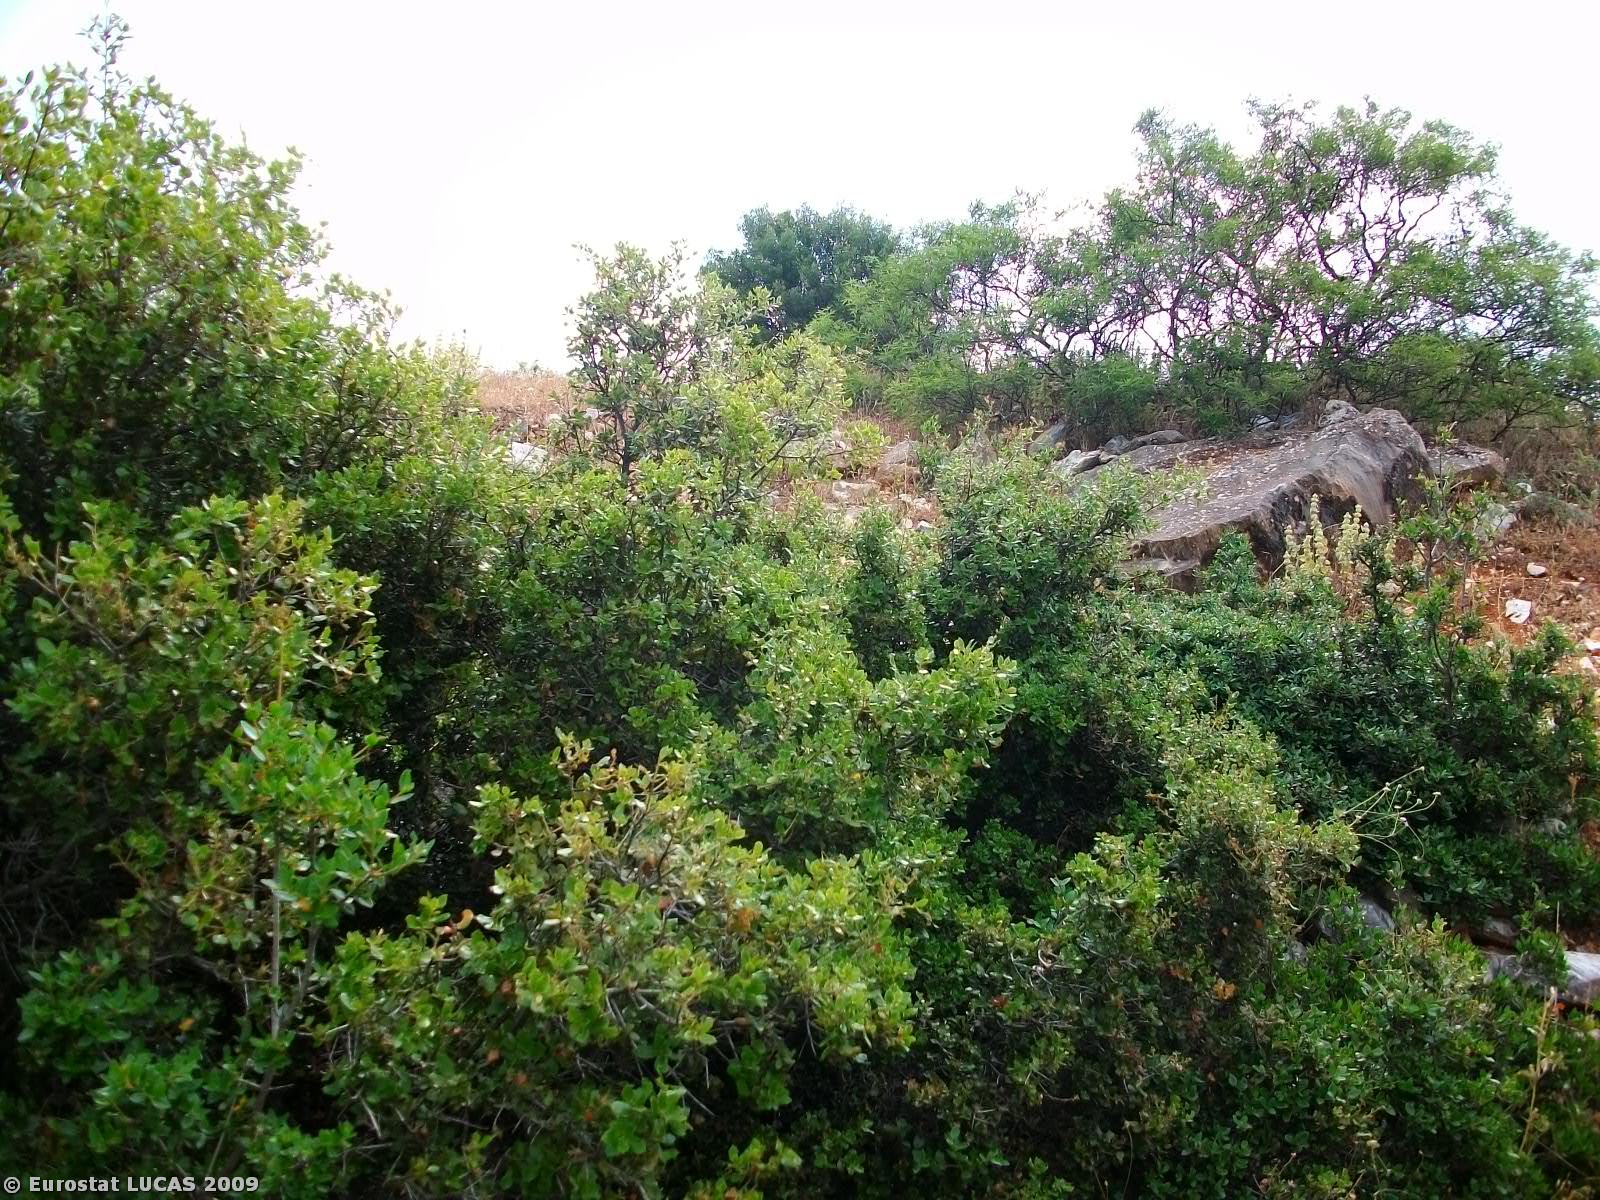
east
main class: Shrubland
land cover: Shrubland without tree cover
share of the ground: > 75 %
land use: Agriculture (excluding fallow land and kitchen gardens)
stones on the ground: > 50 %
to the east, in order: Shrubland without tree cover; Grass margins; Paved roads, cycling and walking lanes; Grass margins; Shrubland without tree cover
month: June
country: GR
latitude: 39.5077
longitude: 22.8672
